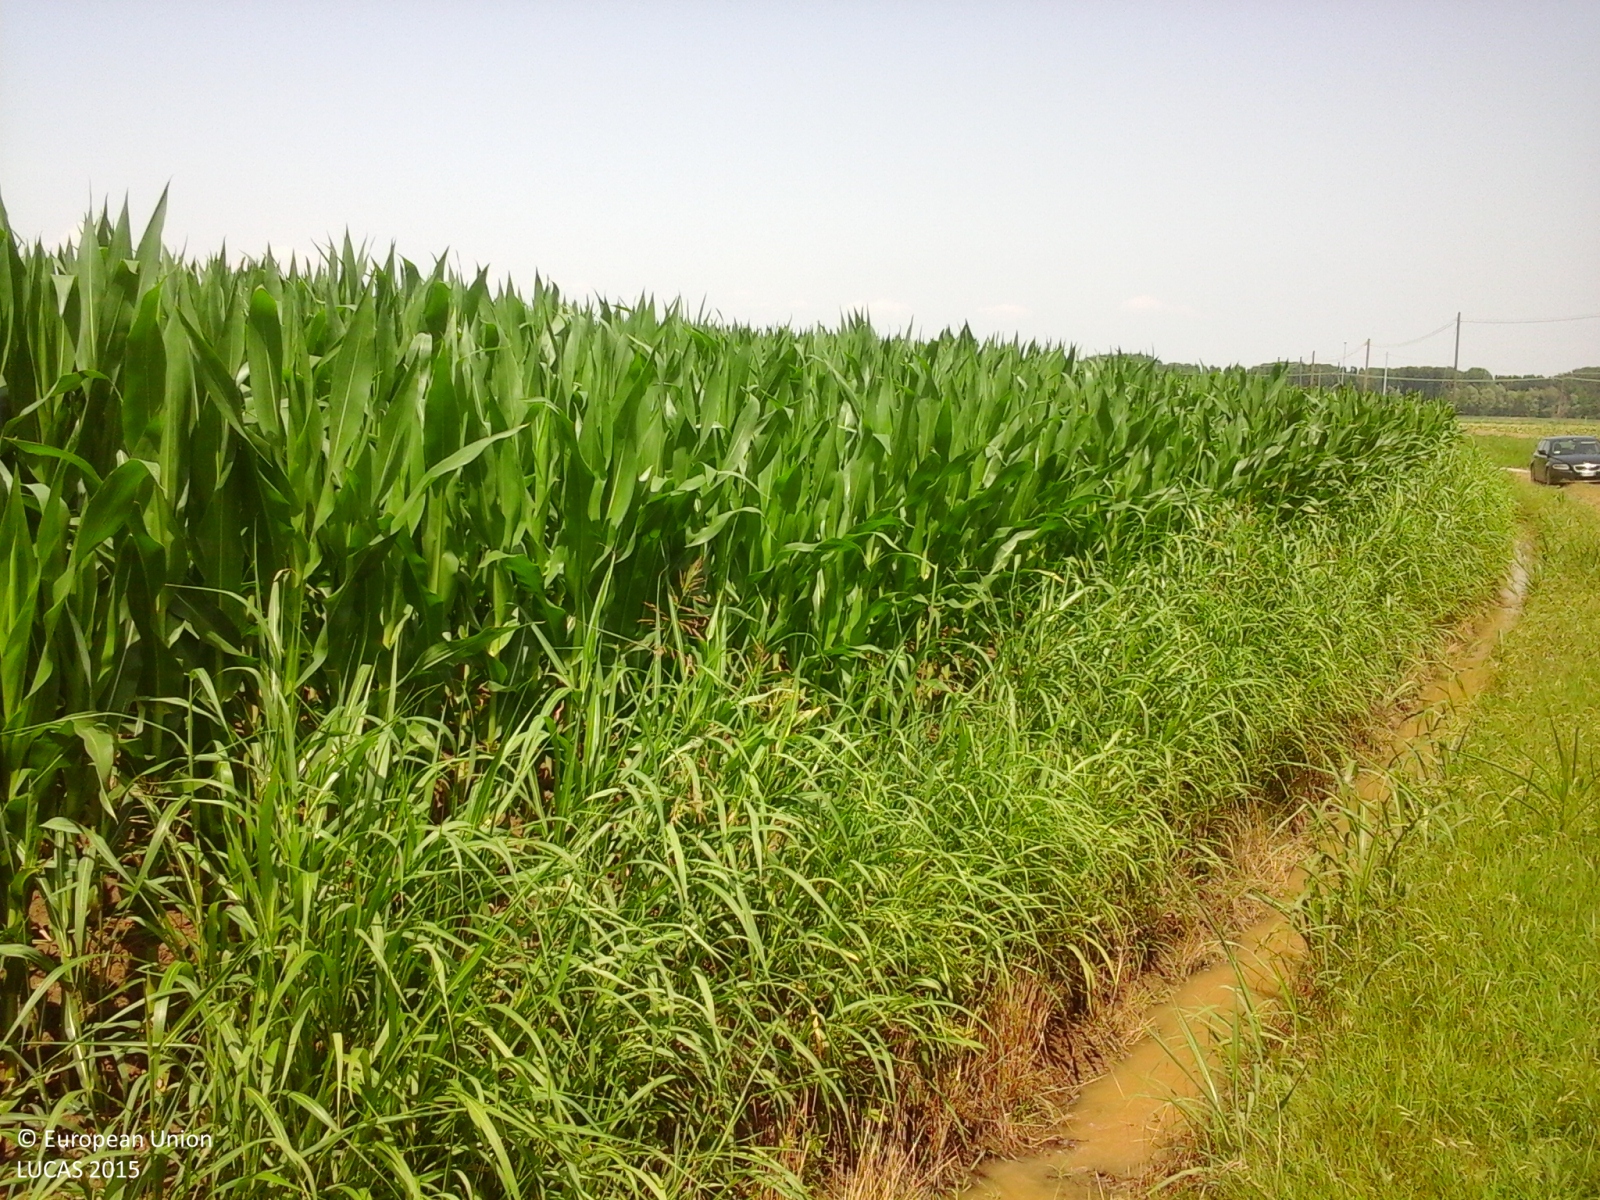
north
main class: Cropland
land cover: Maize
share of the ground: > 75 %
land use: Agriculture (excluding fallow land and kitchen gardens)
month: June
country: IT
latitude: 45.2463
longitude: 11.1064
